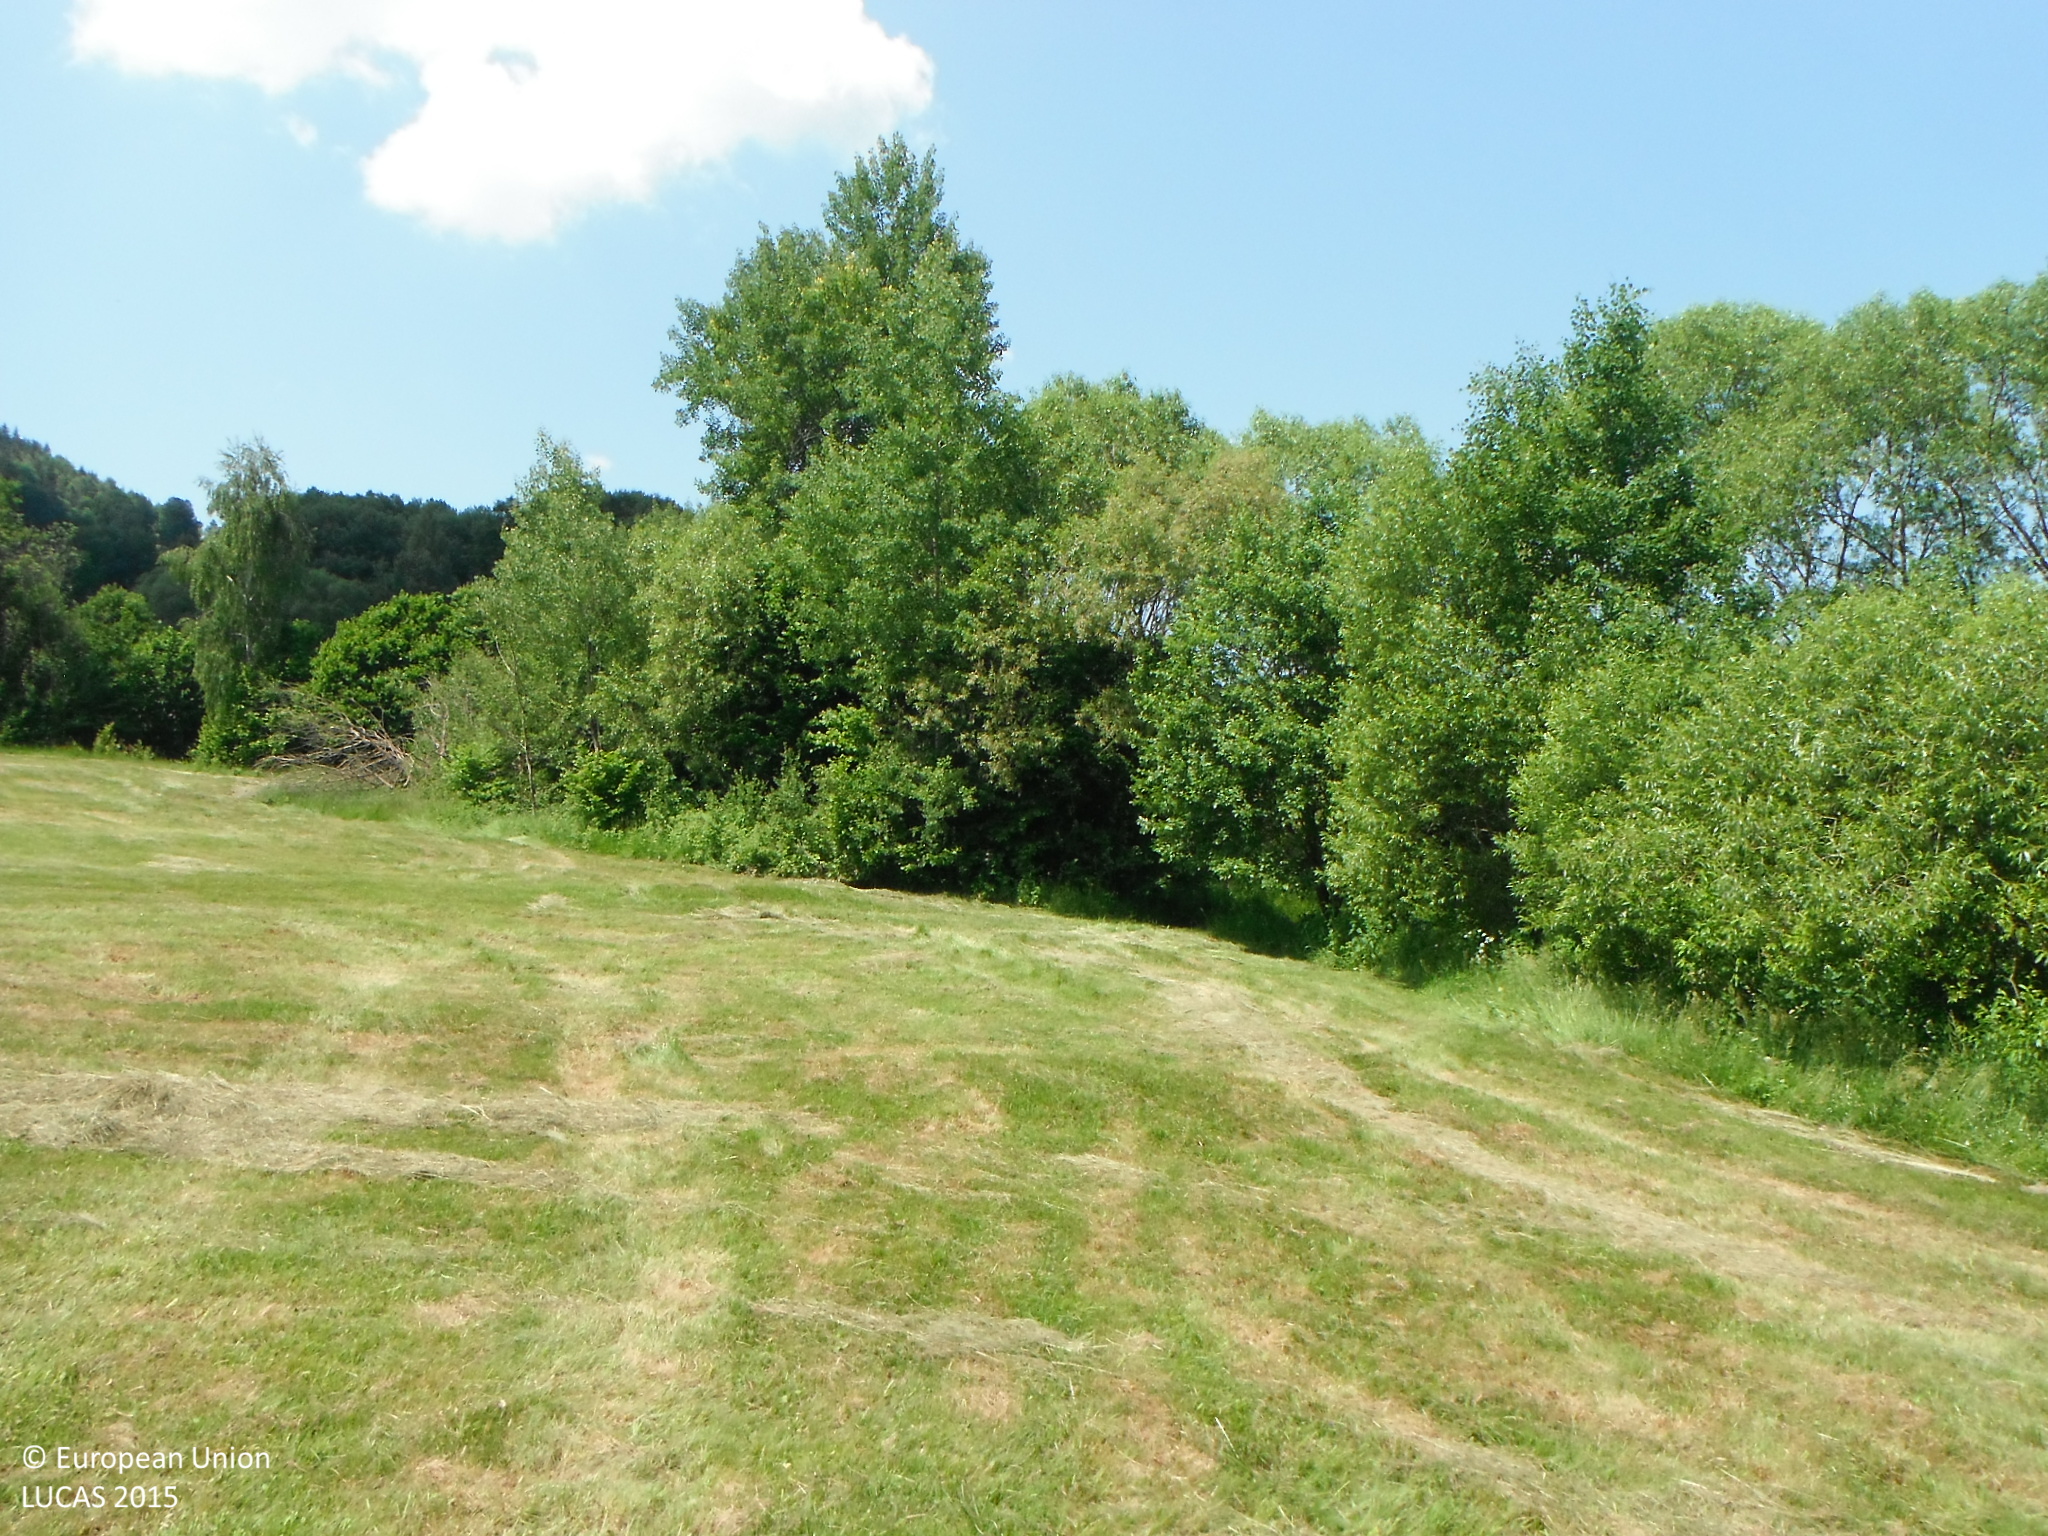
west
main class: Grassland
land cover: Grassland without tree/shrub cover
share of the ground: > 75 %
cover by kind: herbaceous plants 100 %
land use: Agriculture (excluding fallow land and kitchen gardens)
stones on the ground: < 10 %
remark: Harvested field
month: June
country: SK
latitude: 48.7097
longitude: 19.3878
